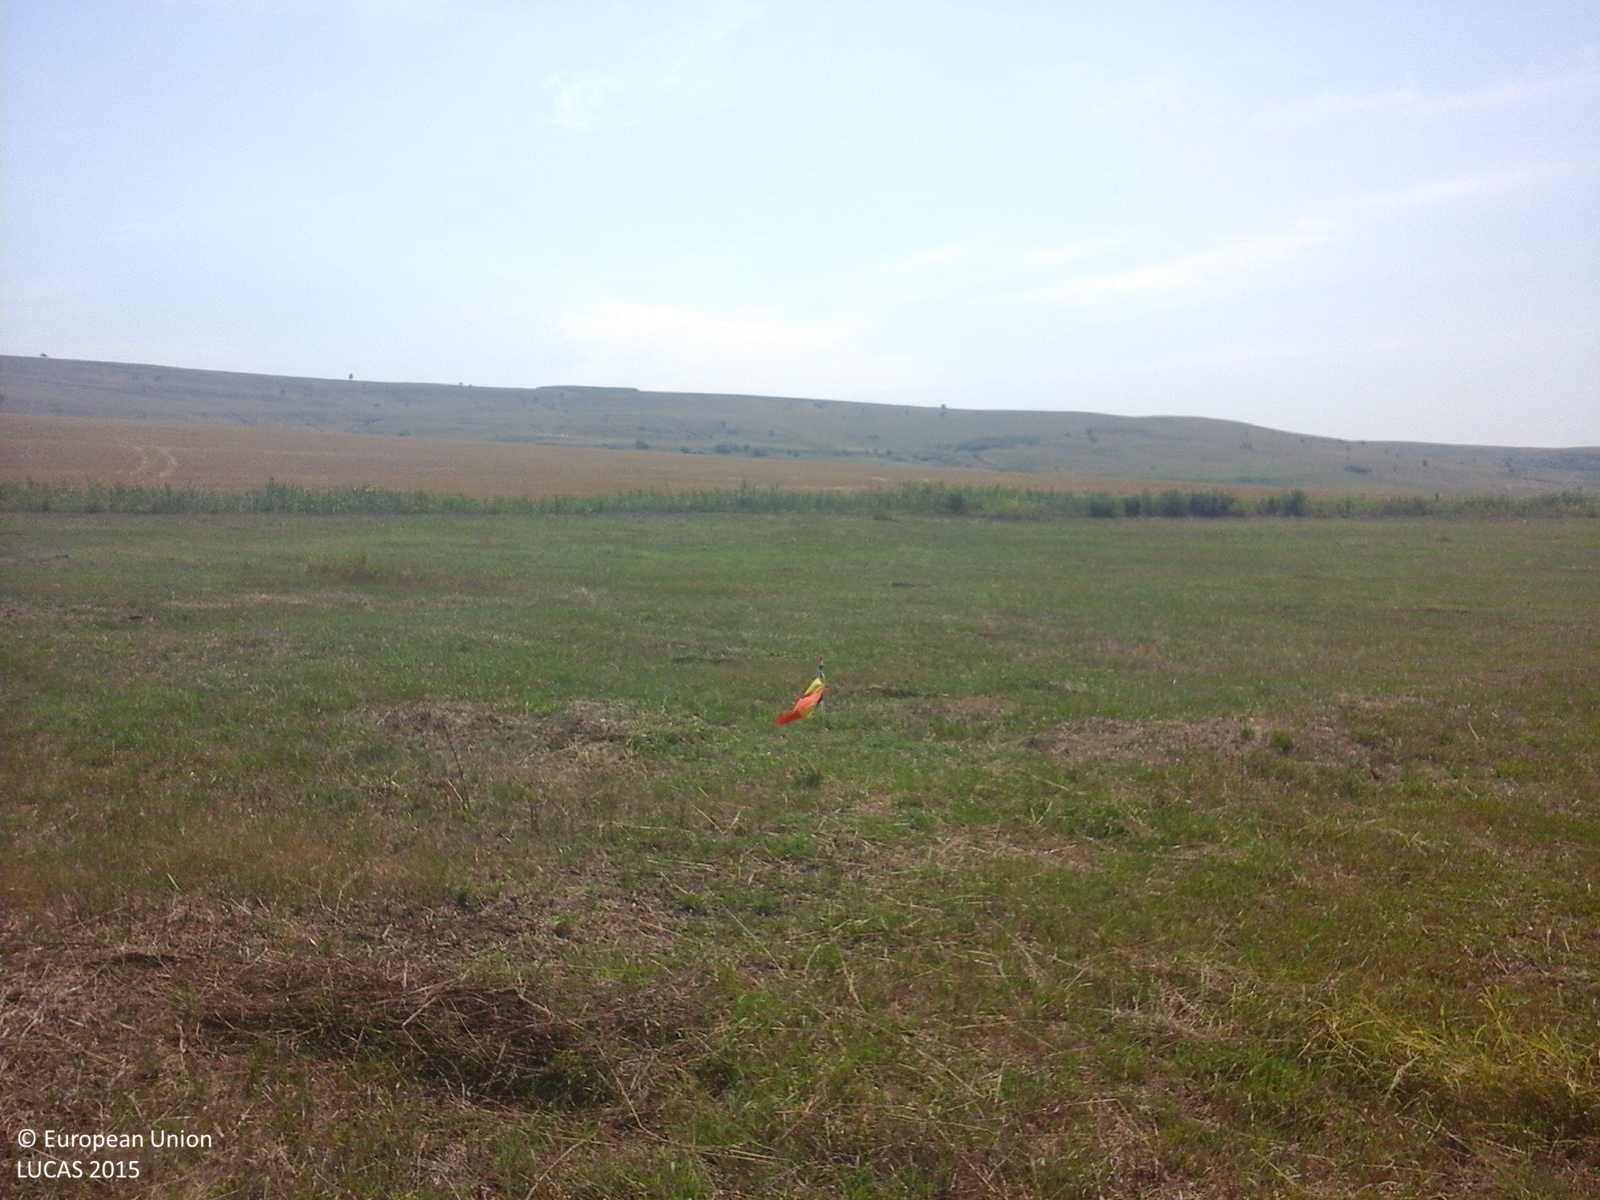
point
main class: Grassland
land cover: Grassland without tree/shrub cover
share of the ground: > 75 %
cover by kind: herbaceous plants 100 %
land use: Agriculture (excluding fallow land and kitchen gardens)
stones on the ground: 10 - 25 %
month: July
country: RO
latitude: 46.5401
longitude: 28.1123
